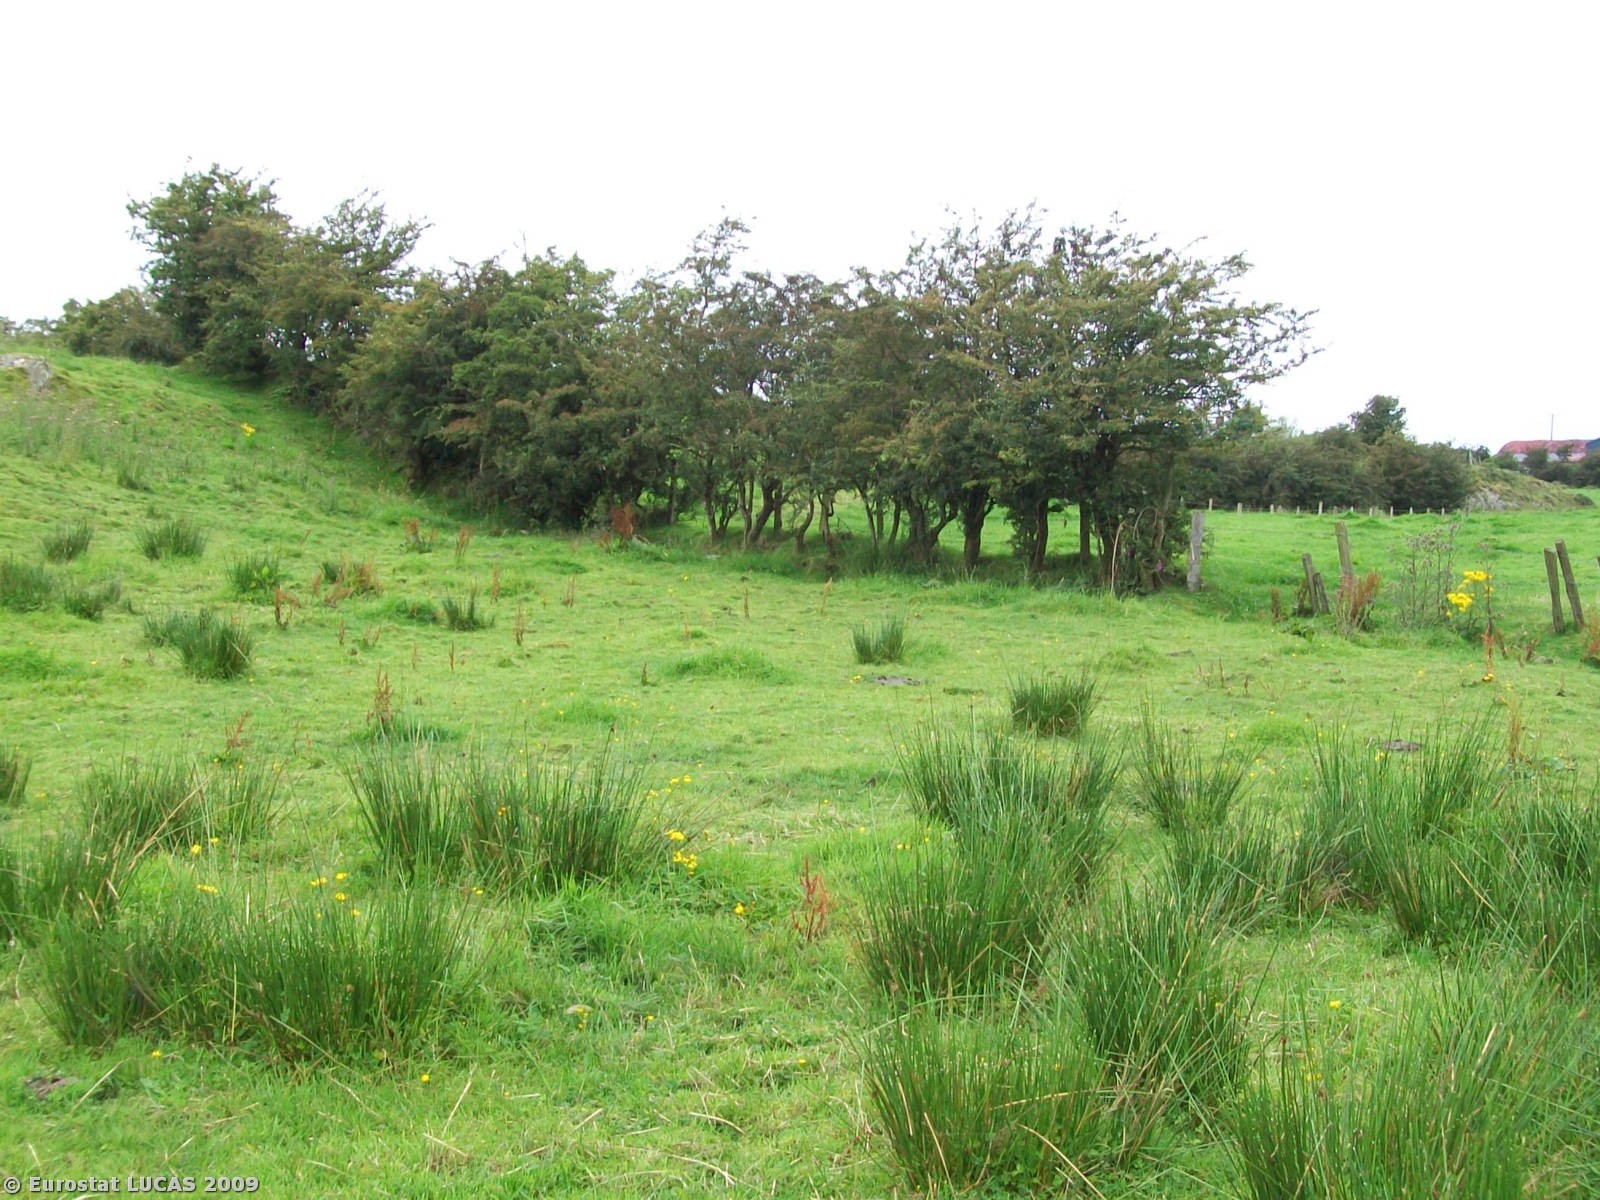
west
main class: Grassland
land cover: Grassland without tree/shrub cover
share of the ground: > 75 %
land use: Agriculture (excluding fallow land and kitchen gardens)
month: August
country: GB
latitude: 54.2152
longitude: -6.7084
